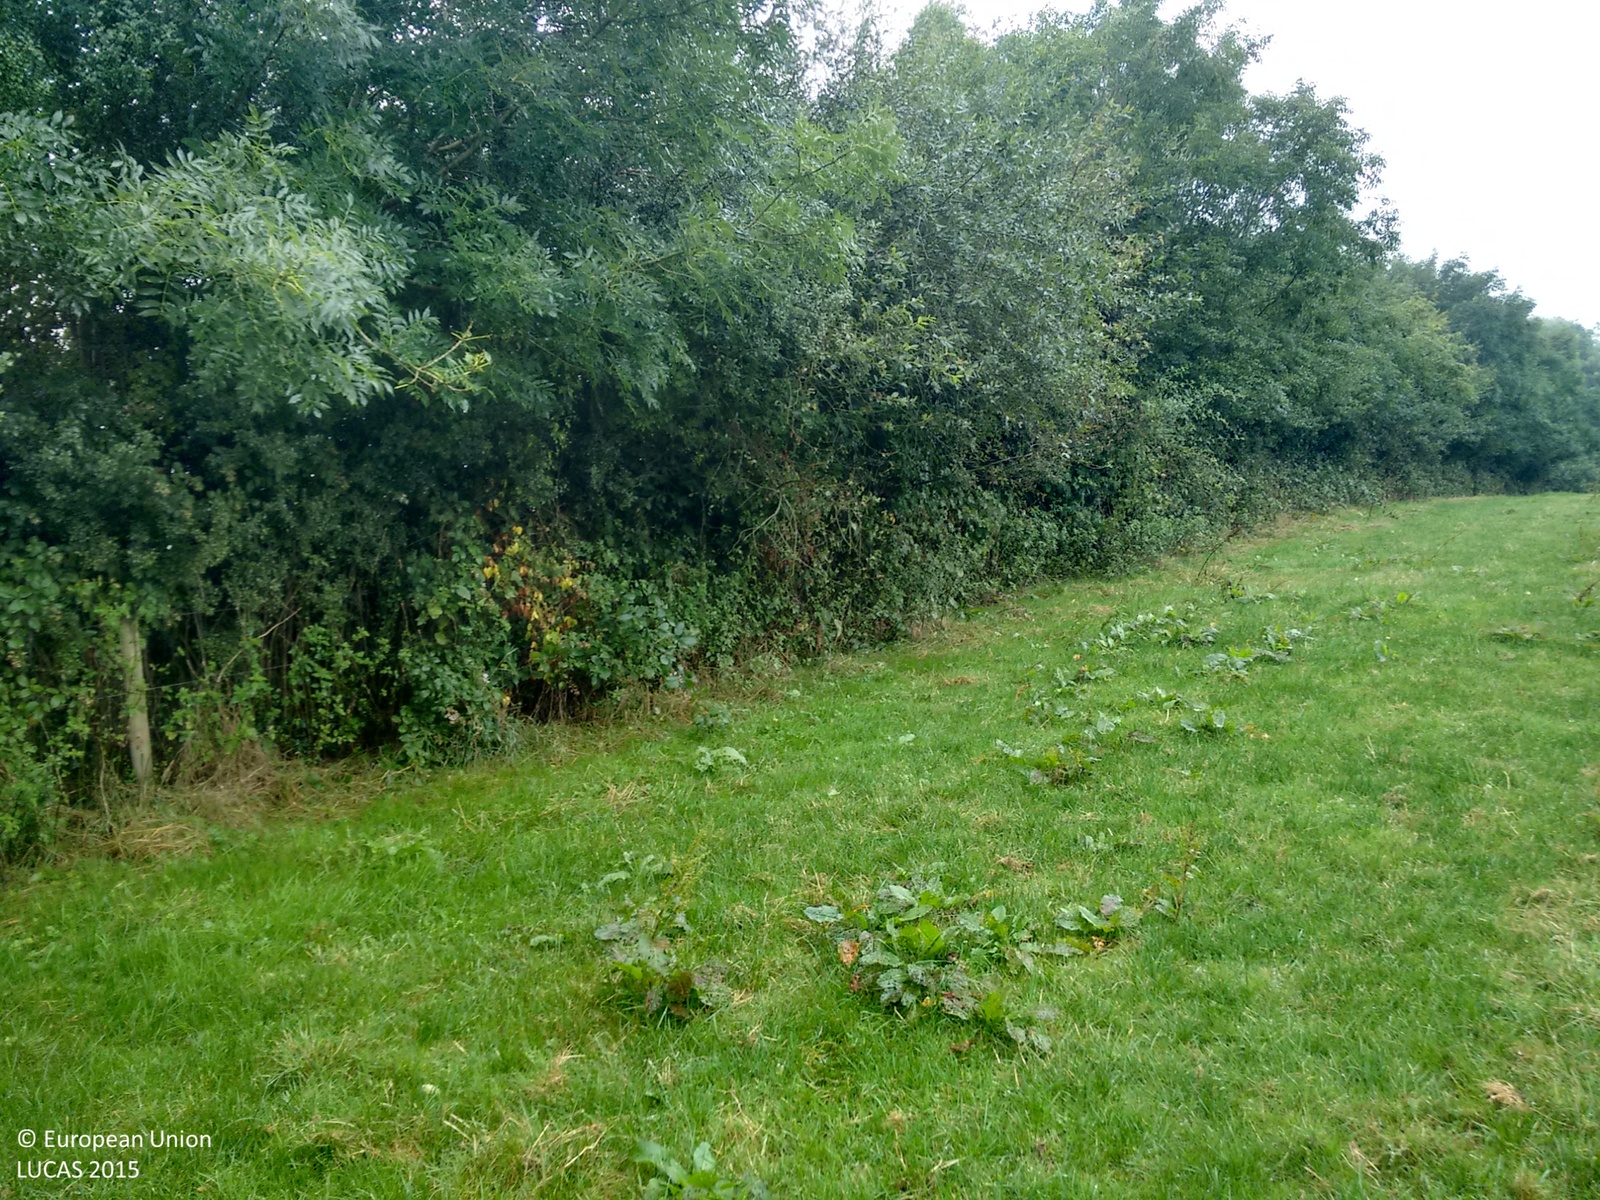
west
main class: Grassland
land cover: Grassland without tree/shrub cover
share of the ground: > 75 %
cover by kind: unconsolidated bare surface 75 %, herbaceous plants 25 %
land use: Agriculture (excluding fallow land and kitchen gardens)
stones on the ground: < 10 %
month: August
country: GB
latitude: 50.9575
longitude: -3.3934
